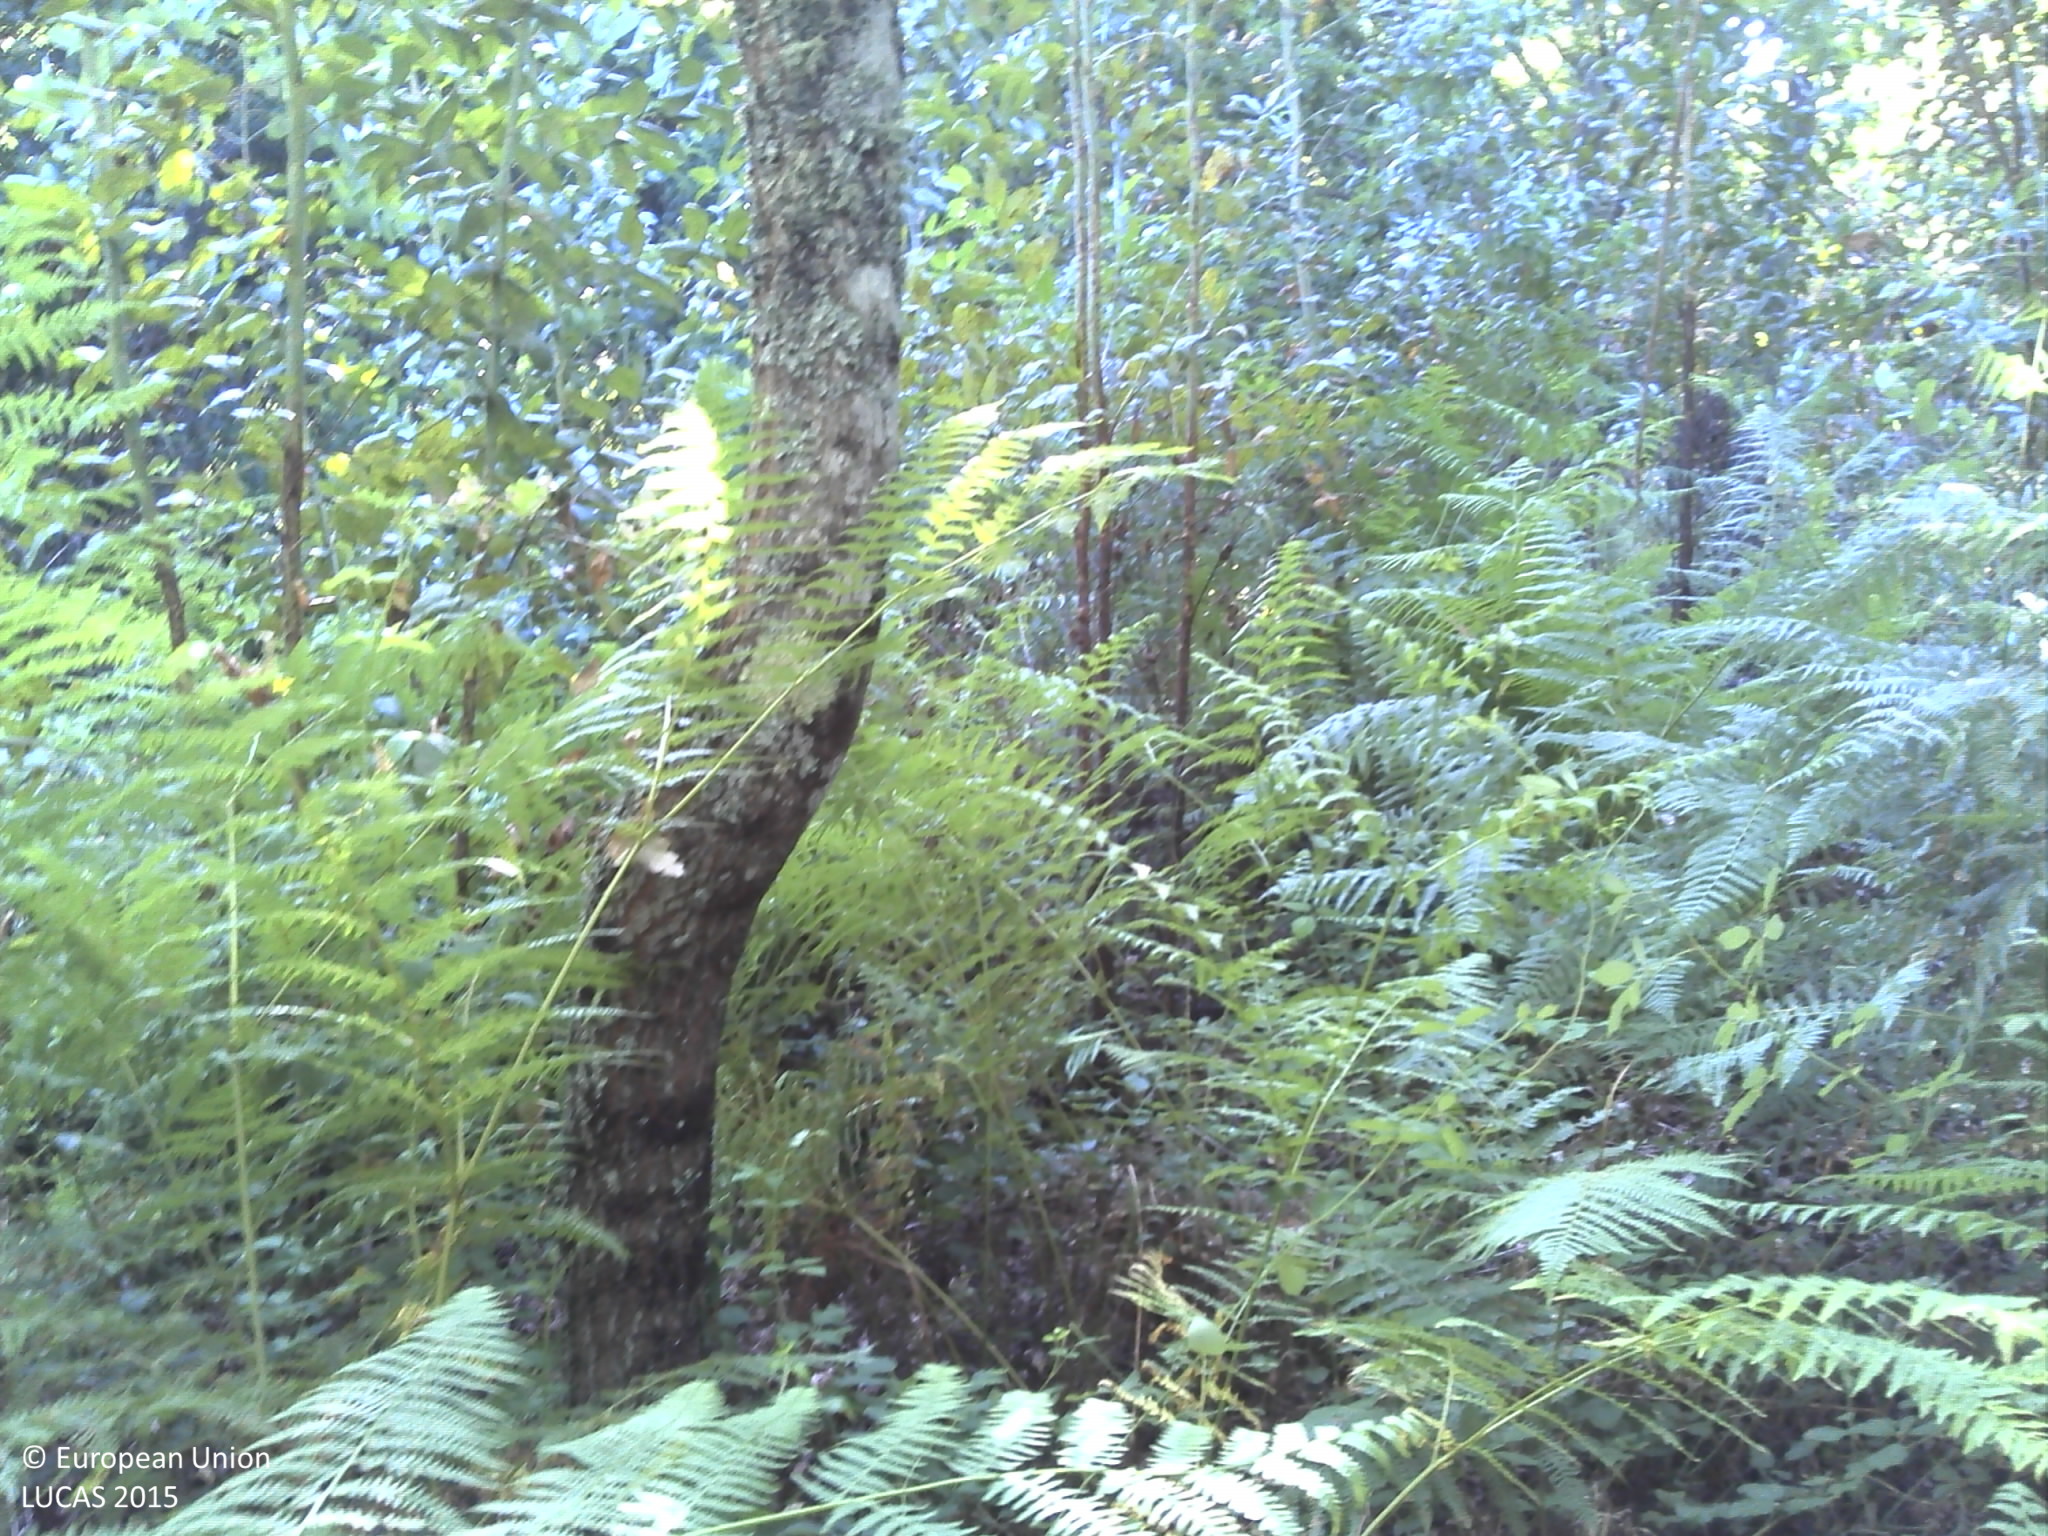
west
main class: Woodland
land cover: Broadleaved woodland
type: thermophilous deciduous forest
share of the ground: 25 - 50 %
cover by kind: unconsolidated bare surface 40 %, broadleaved forest trees 30 %, shrubs 30 %
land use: Forestry
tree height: > 5 m
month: June
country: PT
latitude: 39.9617
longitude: -8.1586
